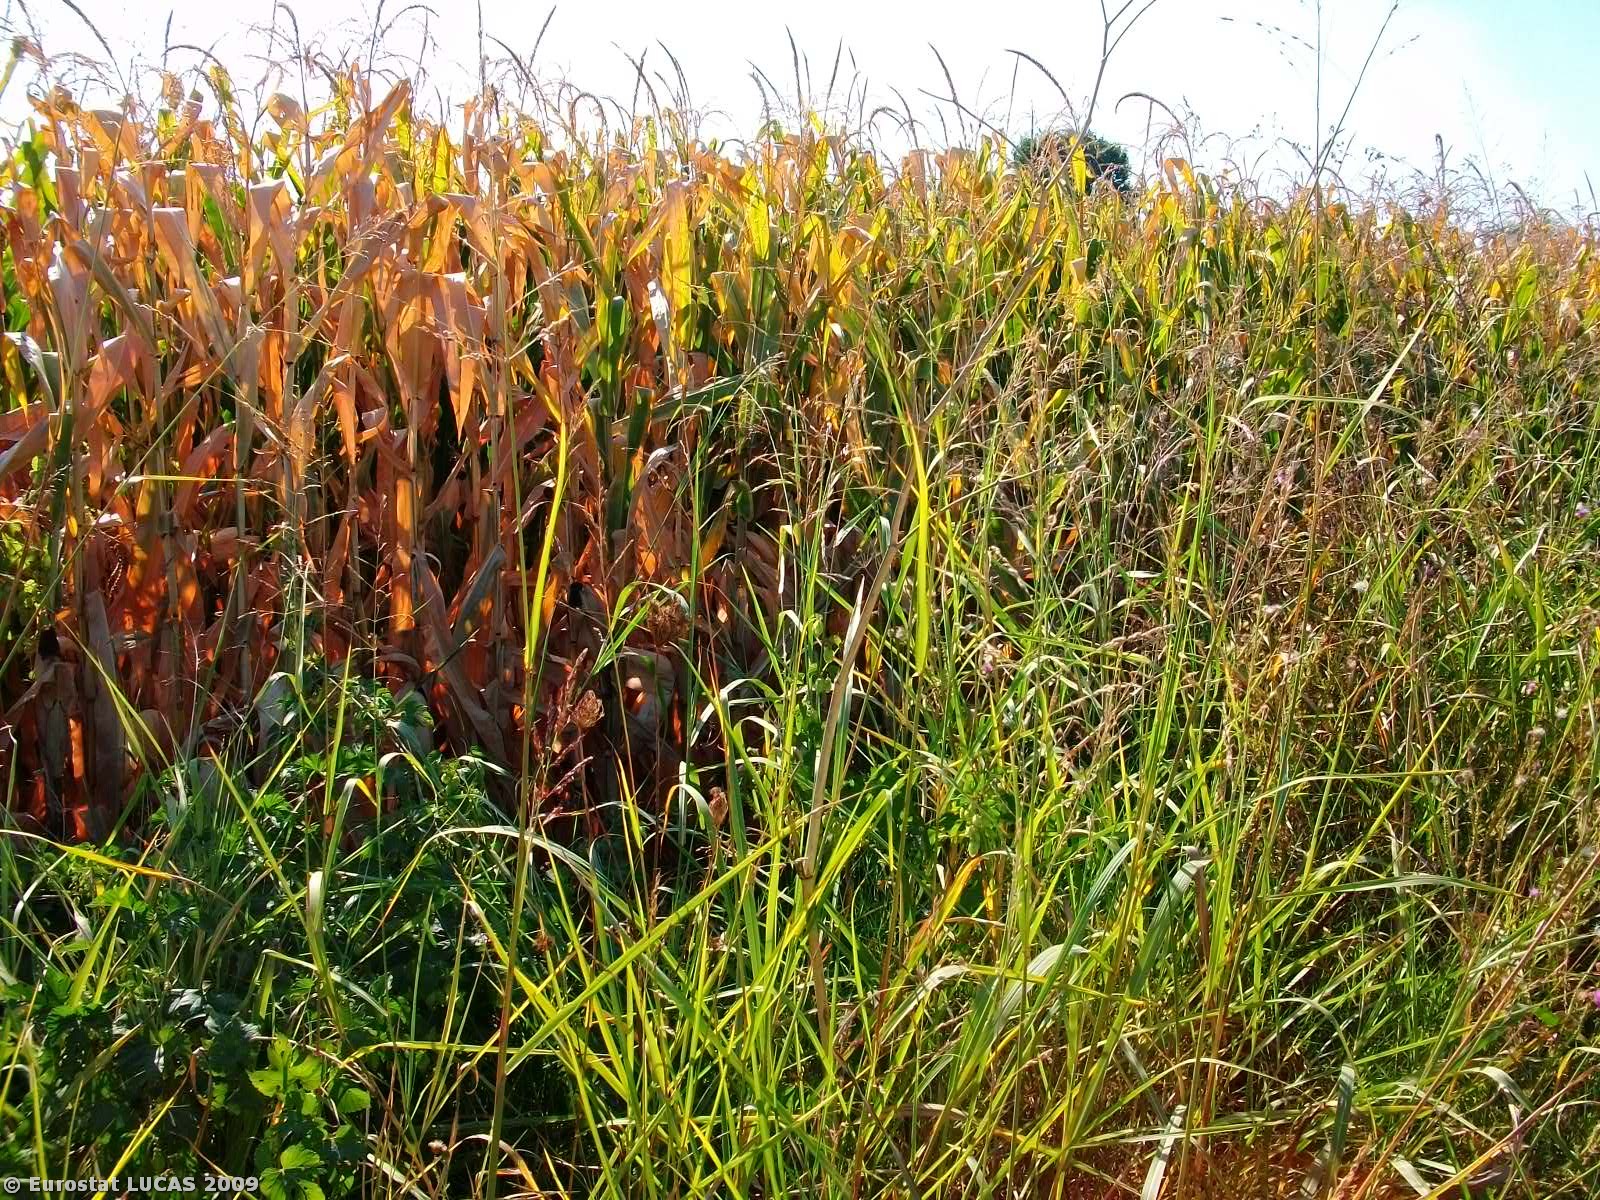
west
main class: Cropland
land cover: Maize
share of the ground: > 75 %
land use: Agriculture (excluding fallow land and kitchen gardens)
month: September
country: GR
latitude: 41.5898
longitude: 26.5764
